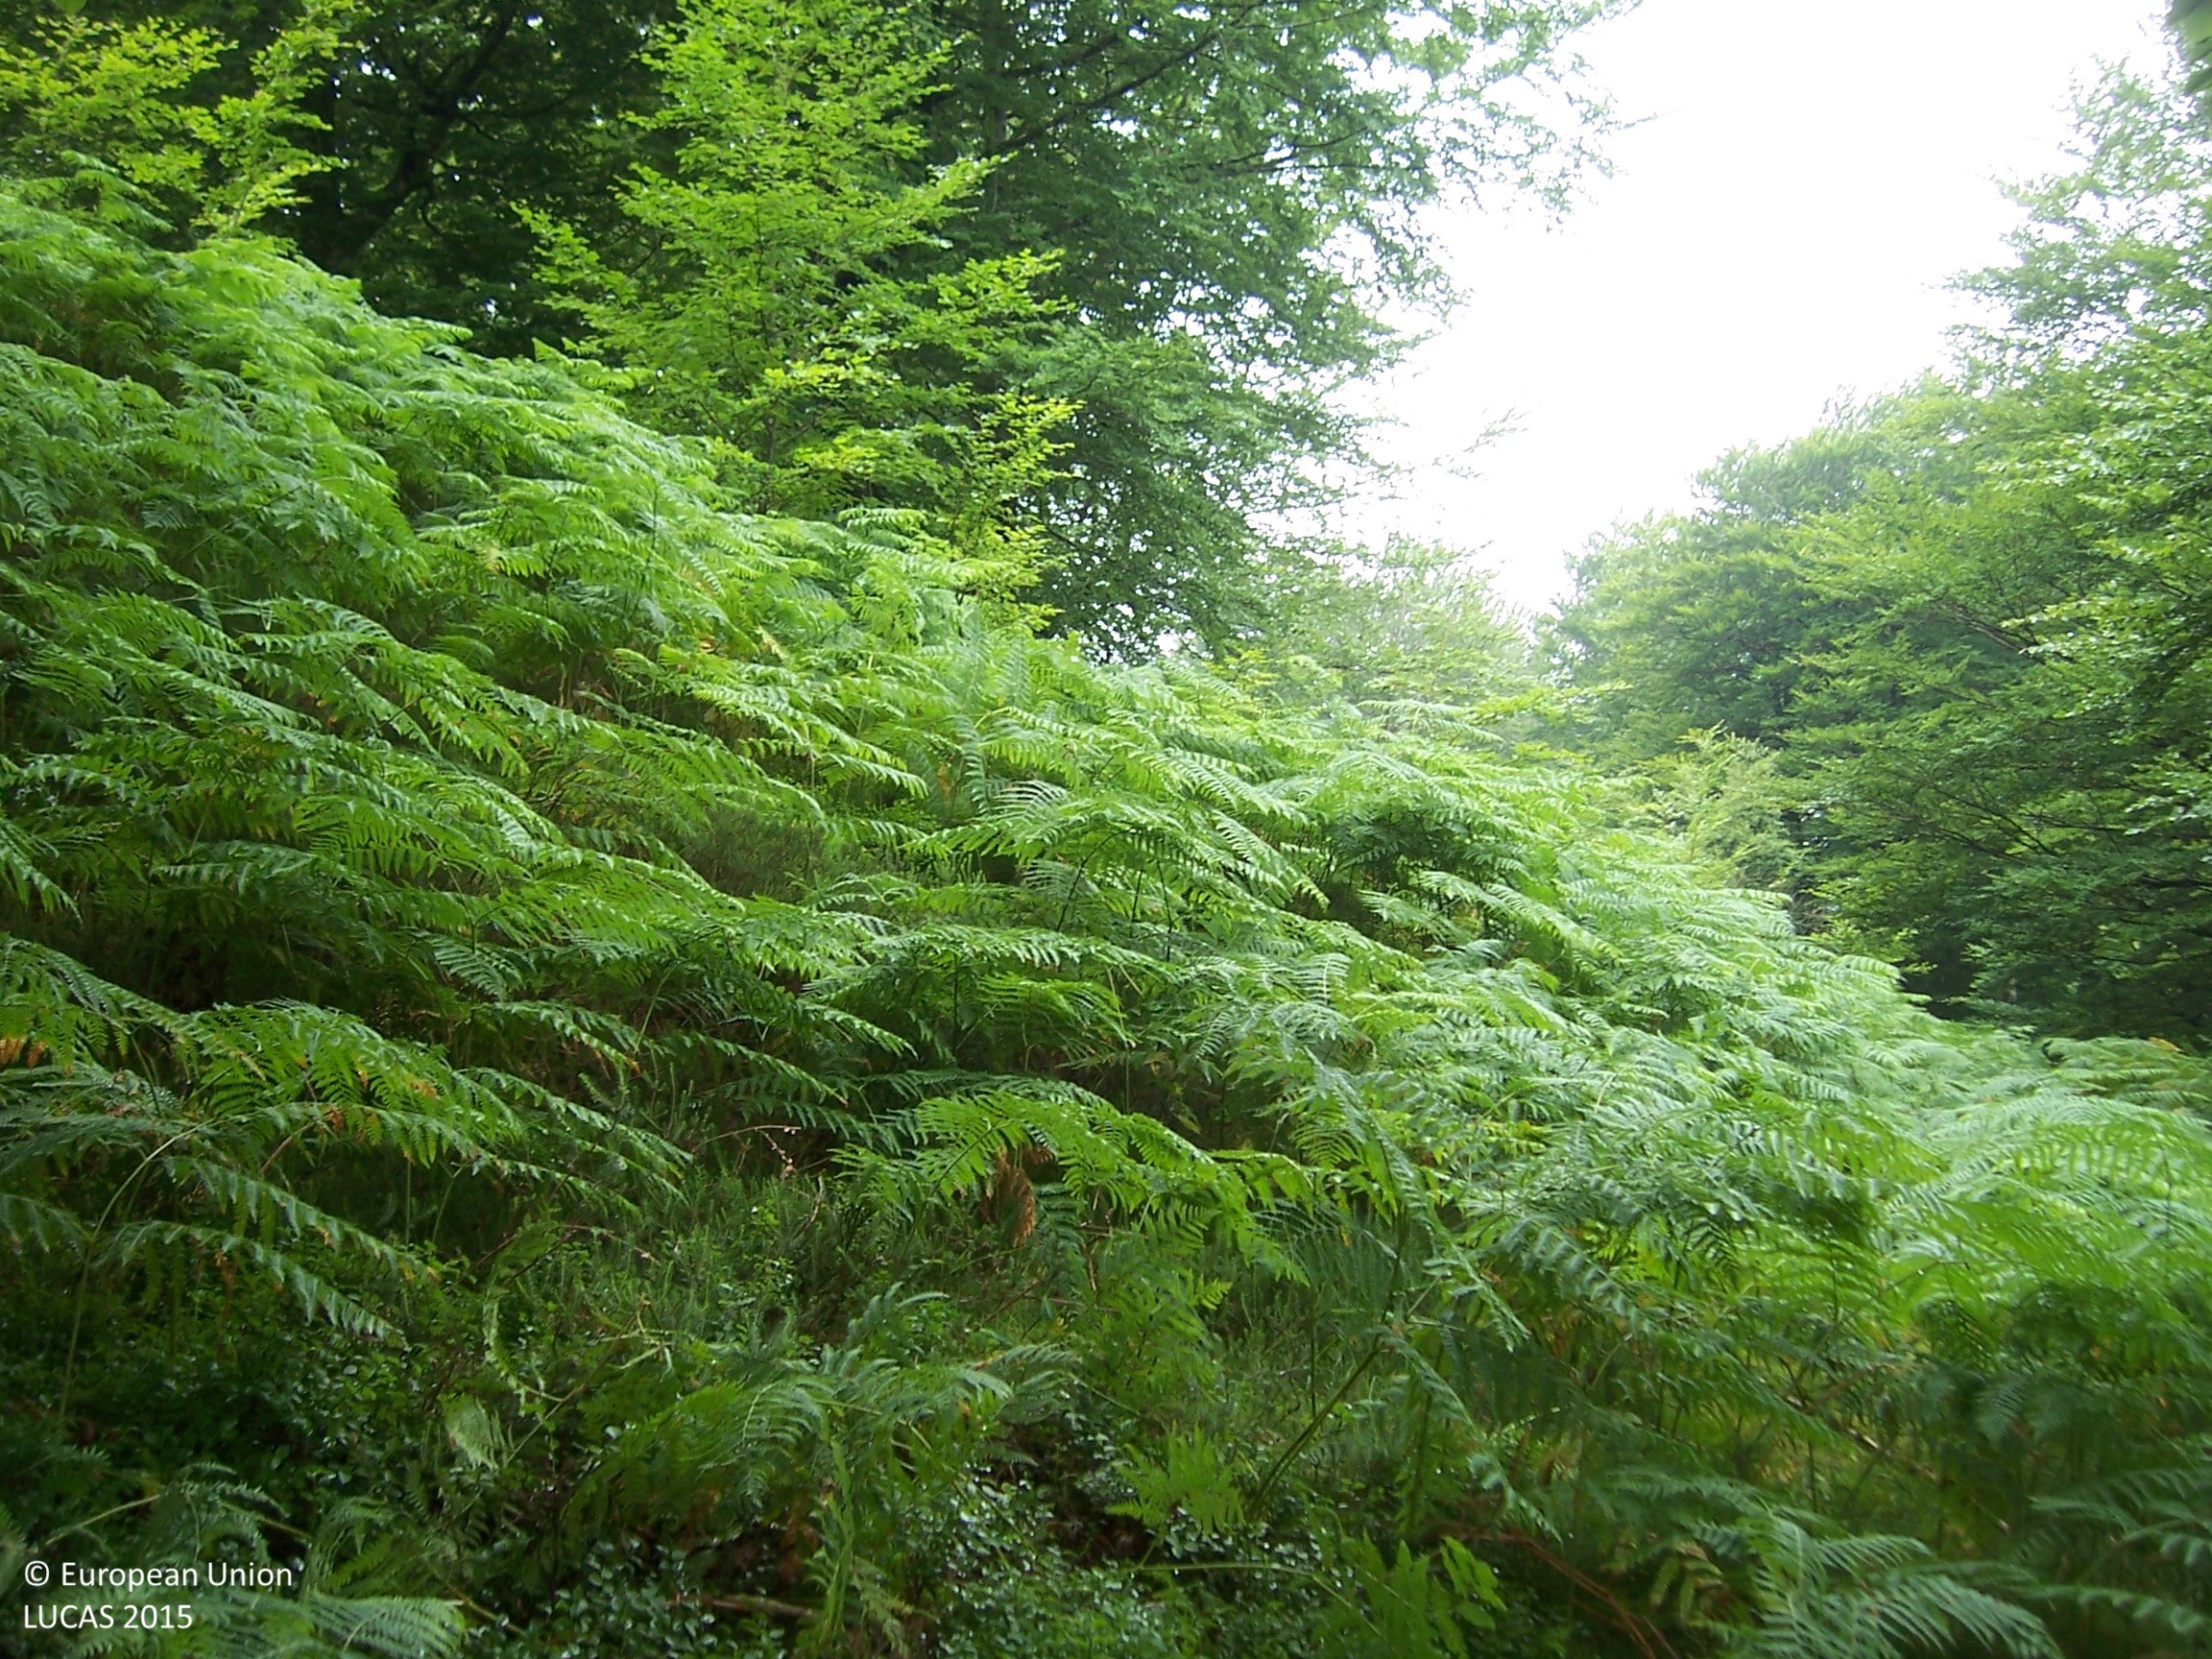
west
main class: Woodland
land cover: Broadleaved woodland
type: beech forest
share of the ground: > 75 %
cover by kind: broadleaved forest trees 90 %, herbaceous plants 10 %
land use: Forestry
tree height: > 5 m
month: July
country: ES
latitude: 43.0691
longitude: -1.5223
